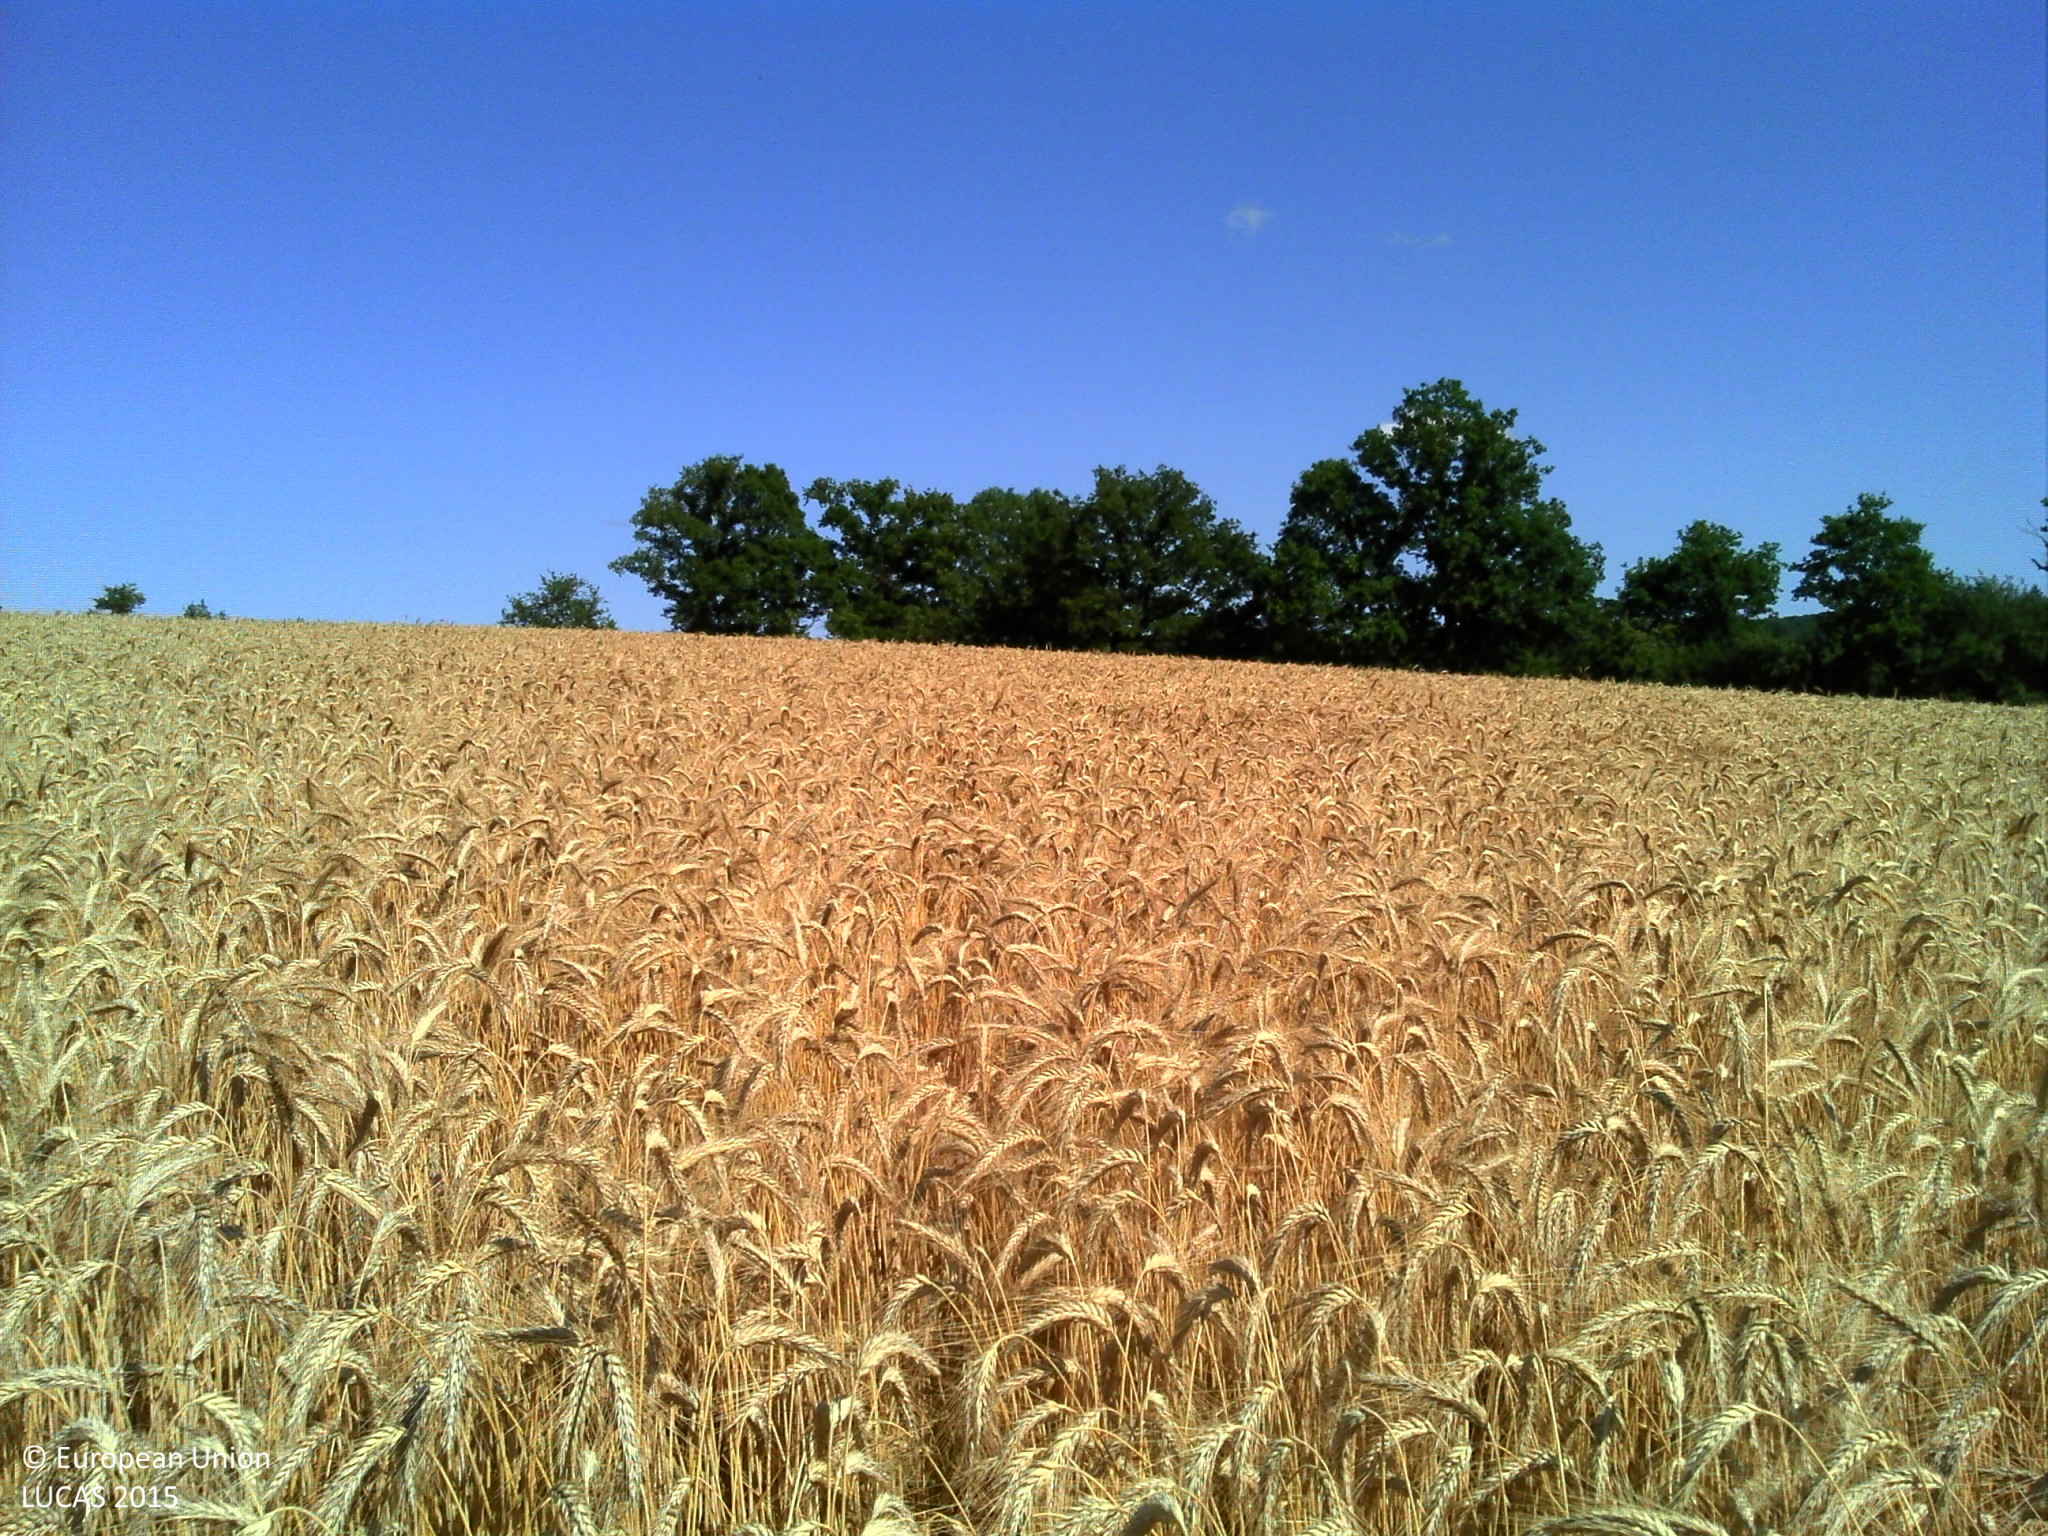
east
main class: Cropland
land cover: Common wheat
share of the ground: > 75 %
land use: Agriculture (excluding fallow land and kitchen gardens)
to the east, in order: Common wheat; Managed hedges; Tracks; Grass margins; Managed hedges; Grassland without tree/shrub cover
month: July
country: FR
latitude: 48.4755
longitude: -0.1903
